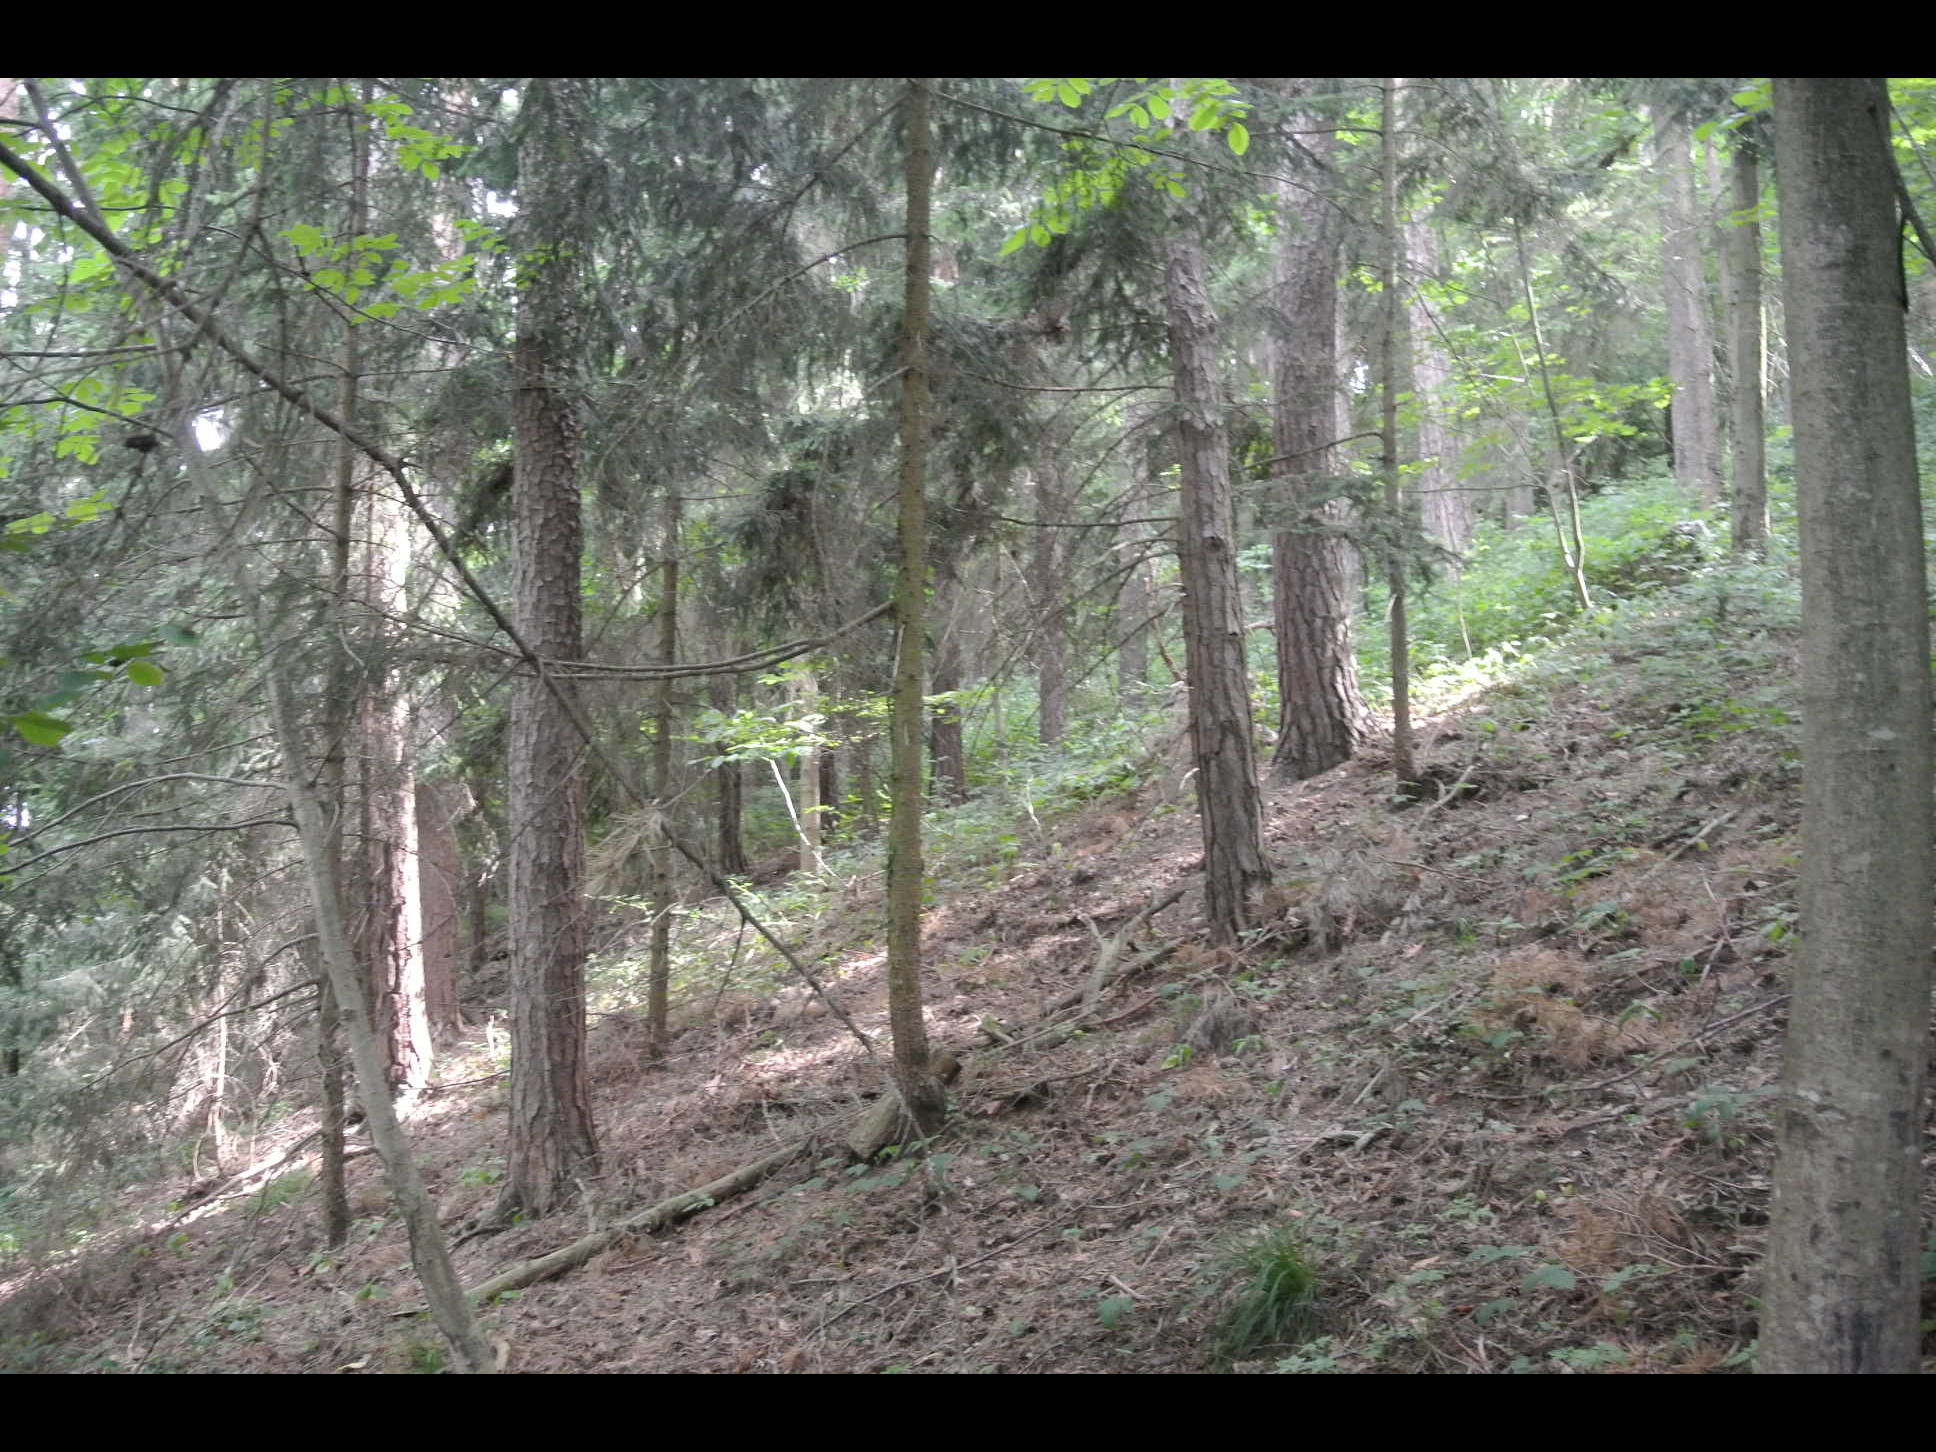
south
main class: Woodland
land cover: Other mixed woodland
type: alpine coniferous forest
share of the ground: > 75 %
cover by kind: coniferous forest trees 70 %, broadleaved forest trees 30 %
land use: Forestry
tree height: > 5 m
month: July
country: AT
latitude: 47.7165
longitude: 16.0145
